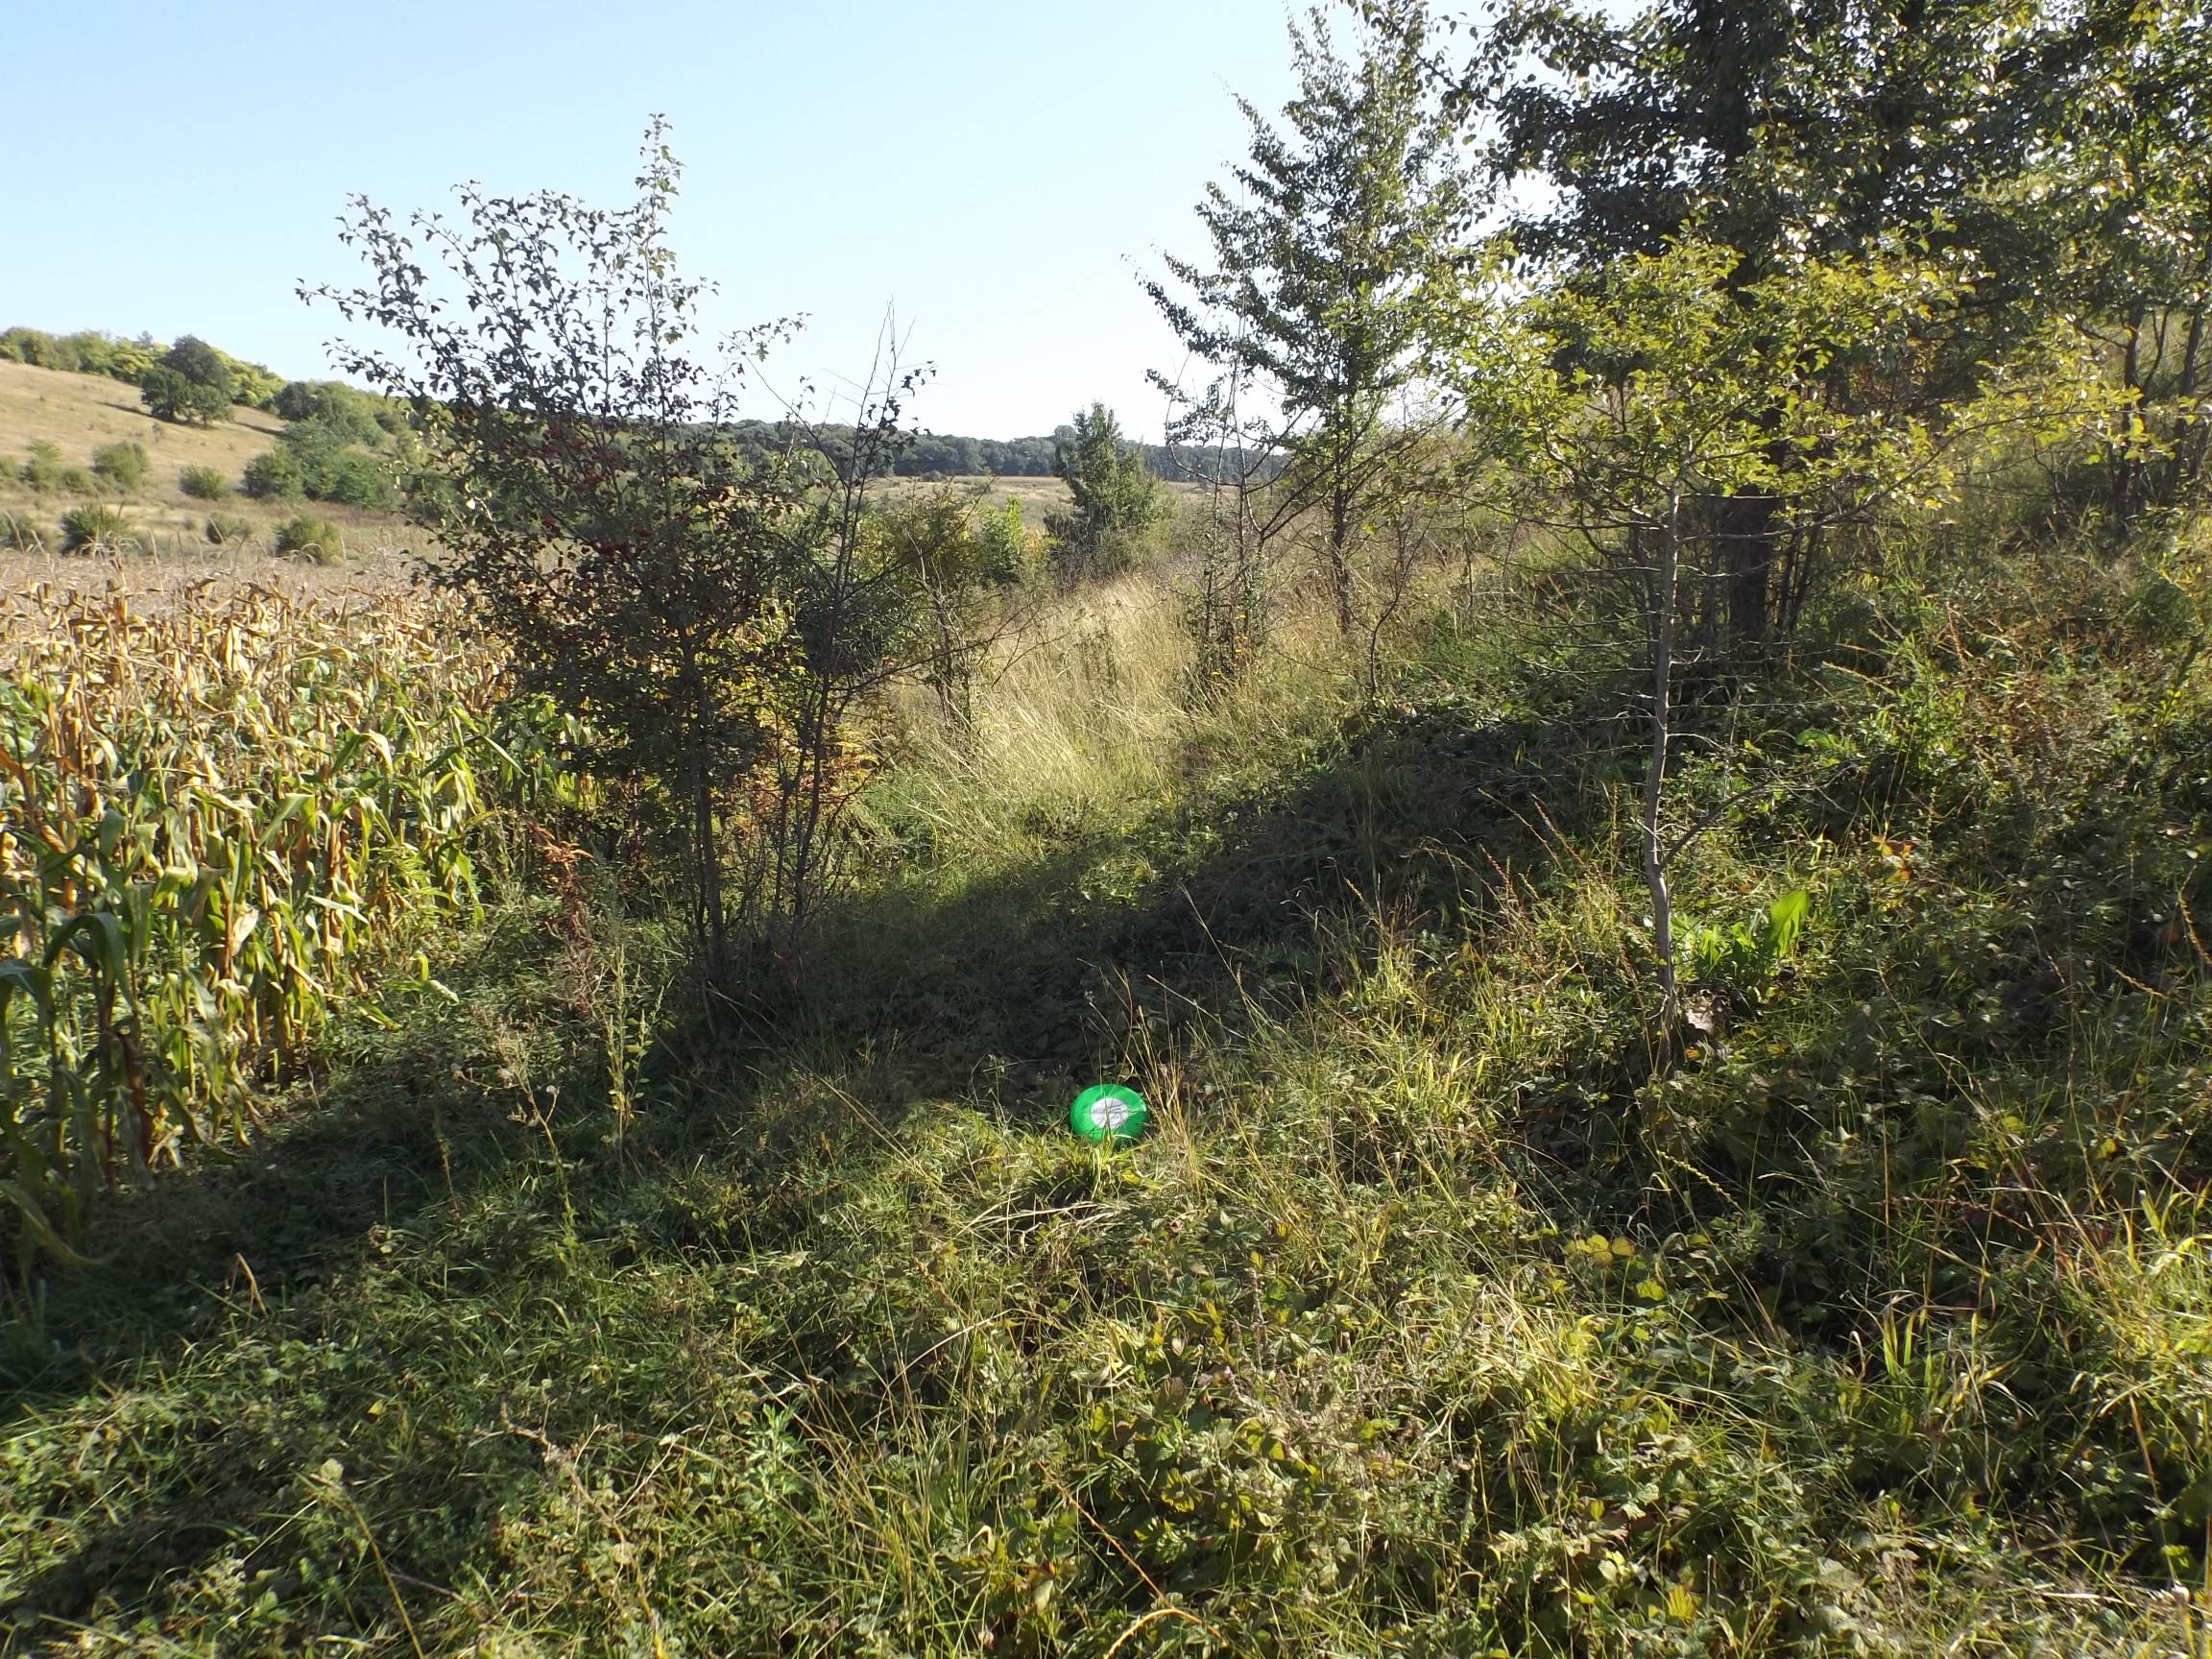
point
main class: Grassland
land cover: Grassland with sparse tree/shrub cover
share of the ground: > 75 %
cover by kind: herbaceous plants 85 %, shrubs 10 %, broadleaved forest trees 5 %
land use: Semi-natural and natural areas not in use
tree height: < 5 m
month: September
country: BG
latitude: 44.0609
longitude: 26.7583
